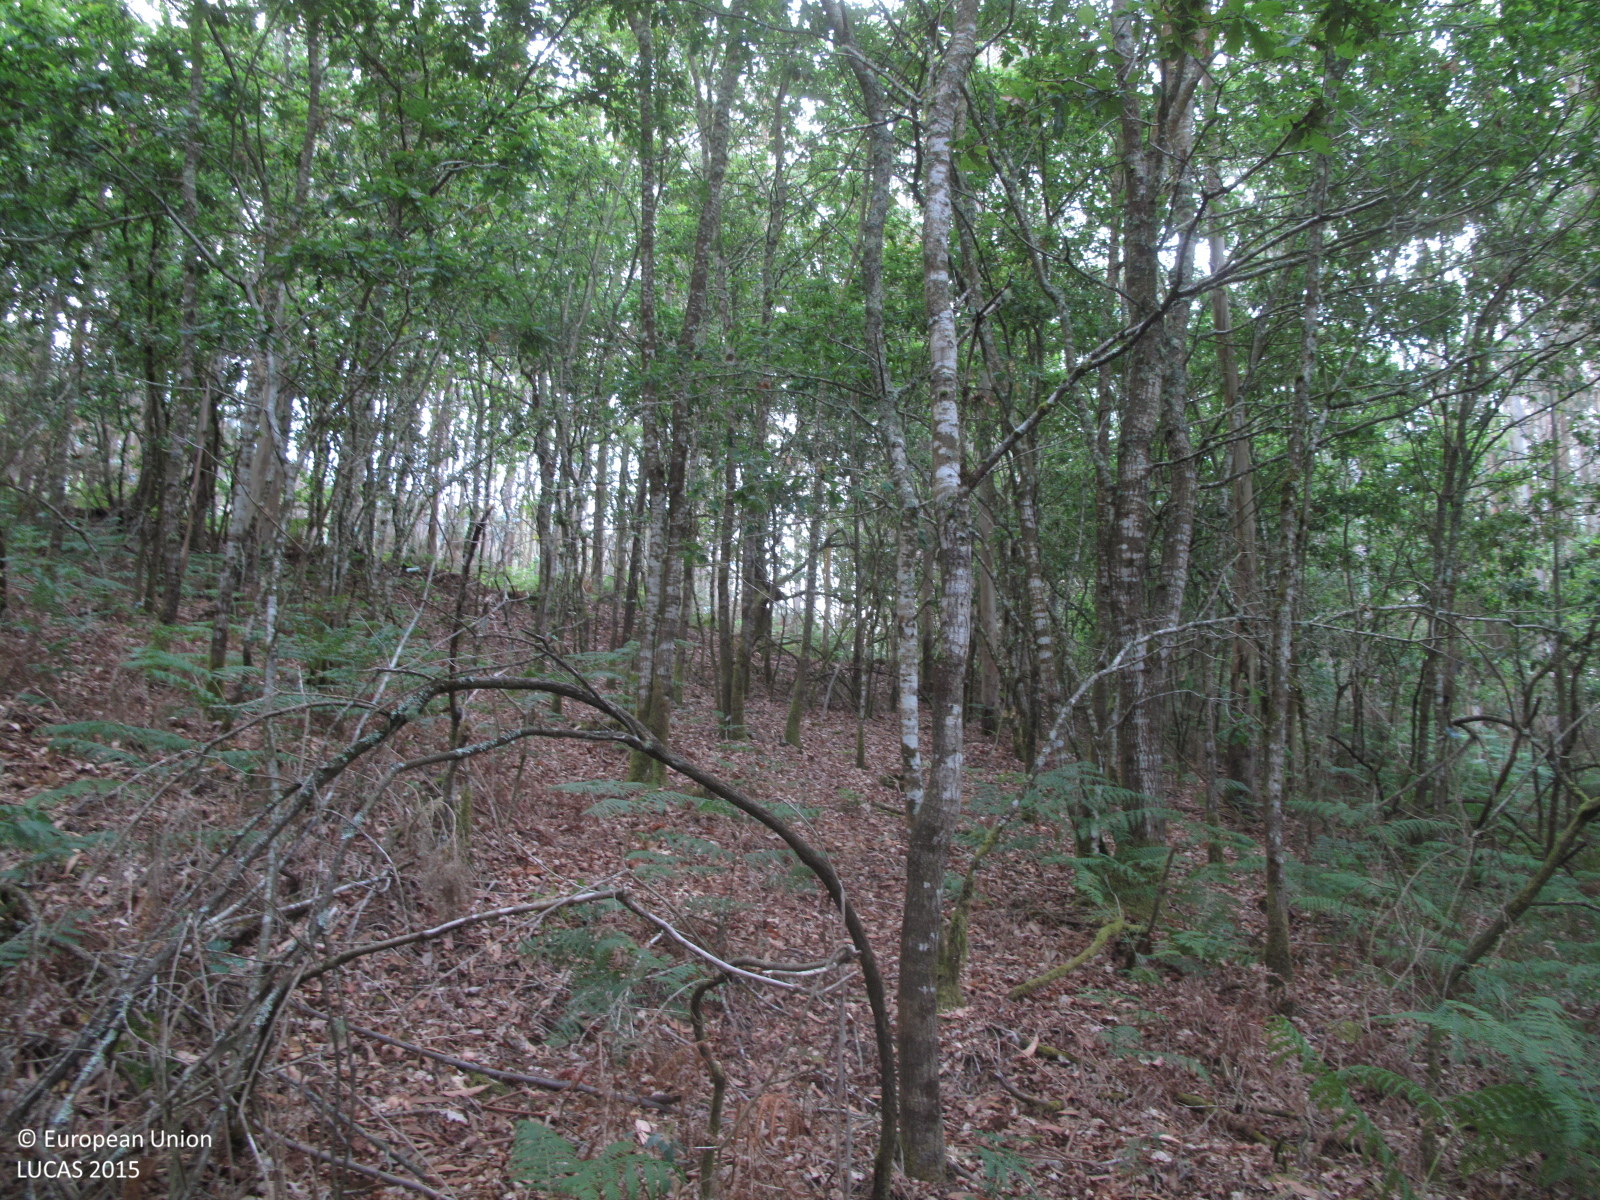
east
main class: Woodland
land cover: Broadleaved woodland
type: acidophilous oak and oak-birch forest
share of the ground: > 75 %
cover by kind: broadleaved forest trees 90 %, herbaceous plants 10 %
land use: Forestry
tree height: > 5 m
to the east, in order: Broadleaved woodland; Tracks; Broadleaved woodland
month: July
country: ES
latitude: 43.2514
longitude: -8.0402
